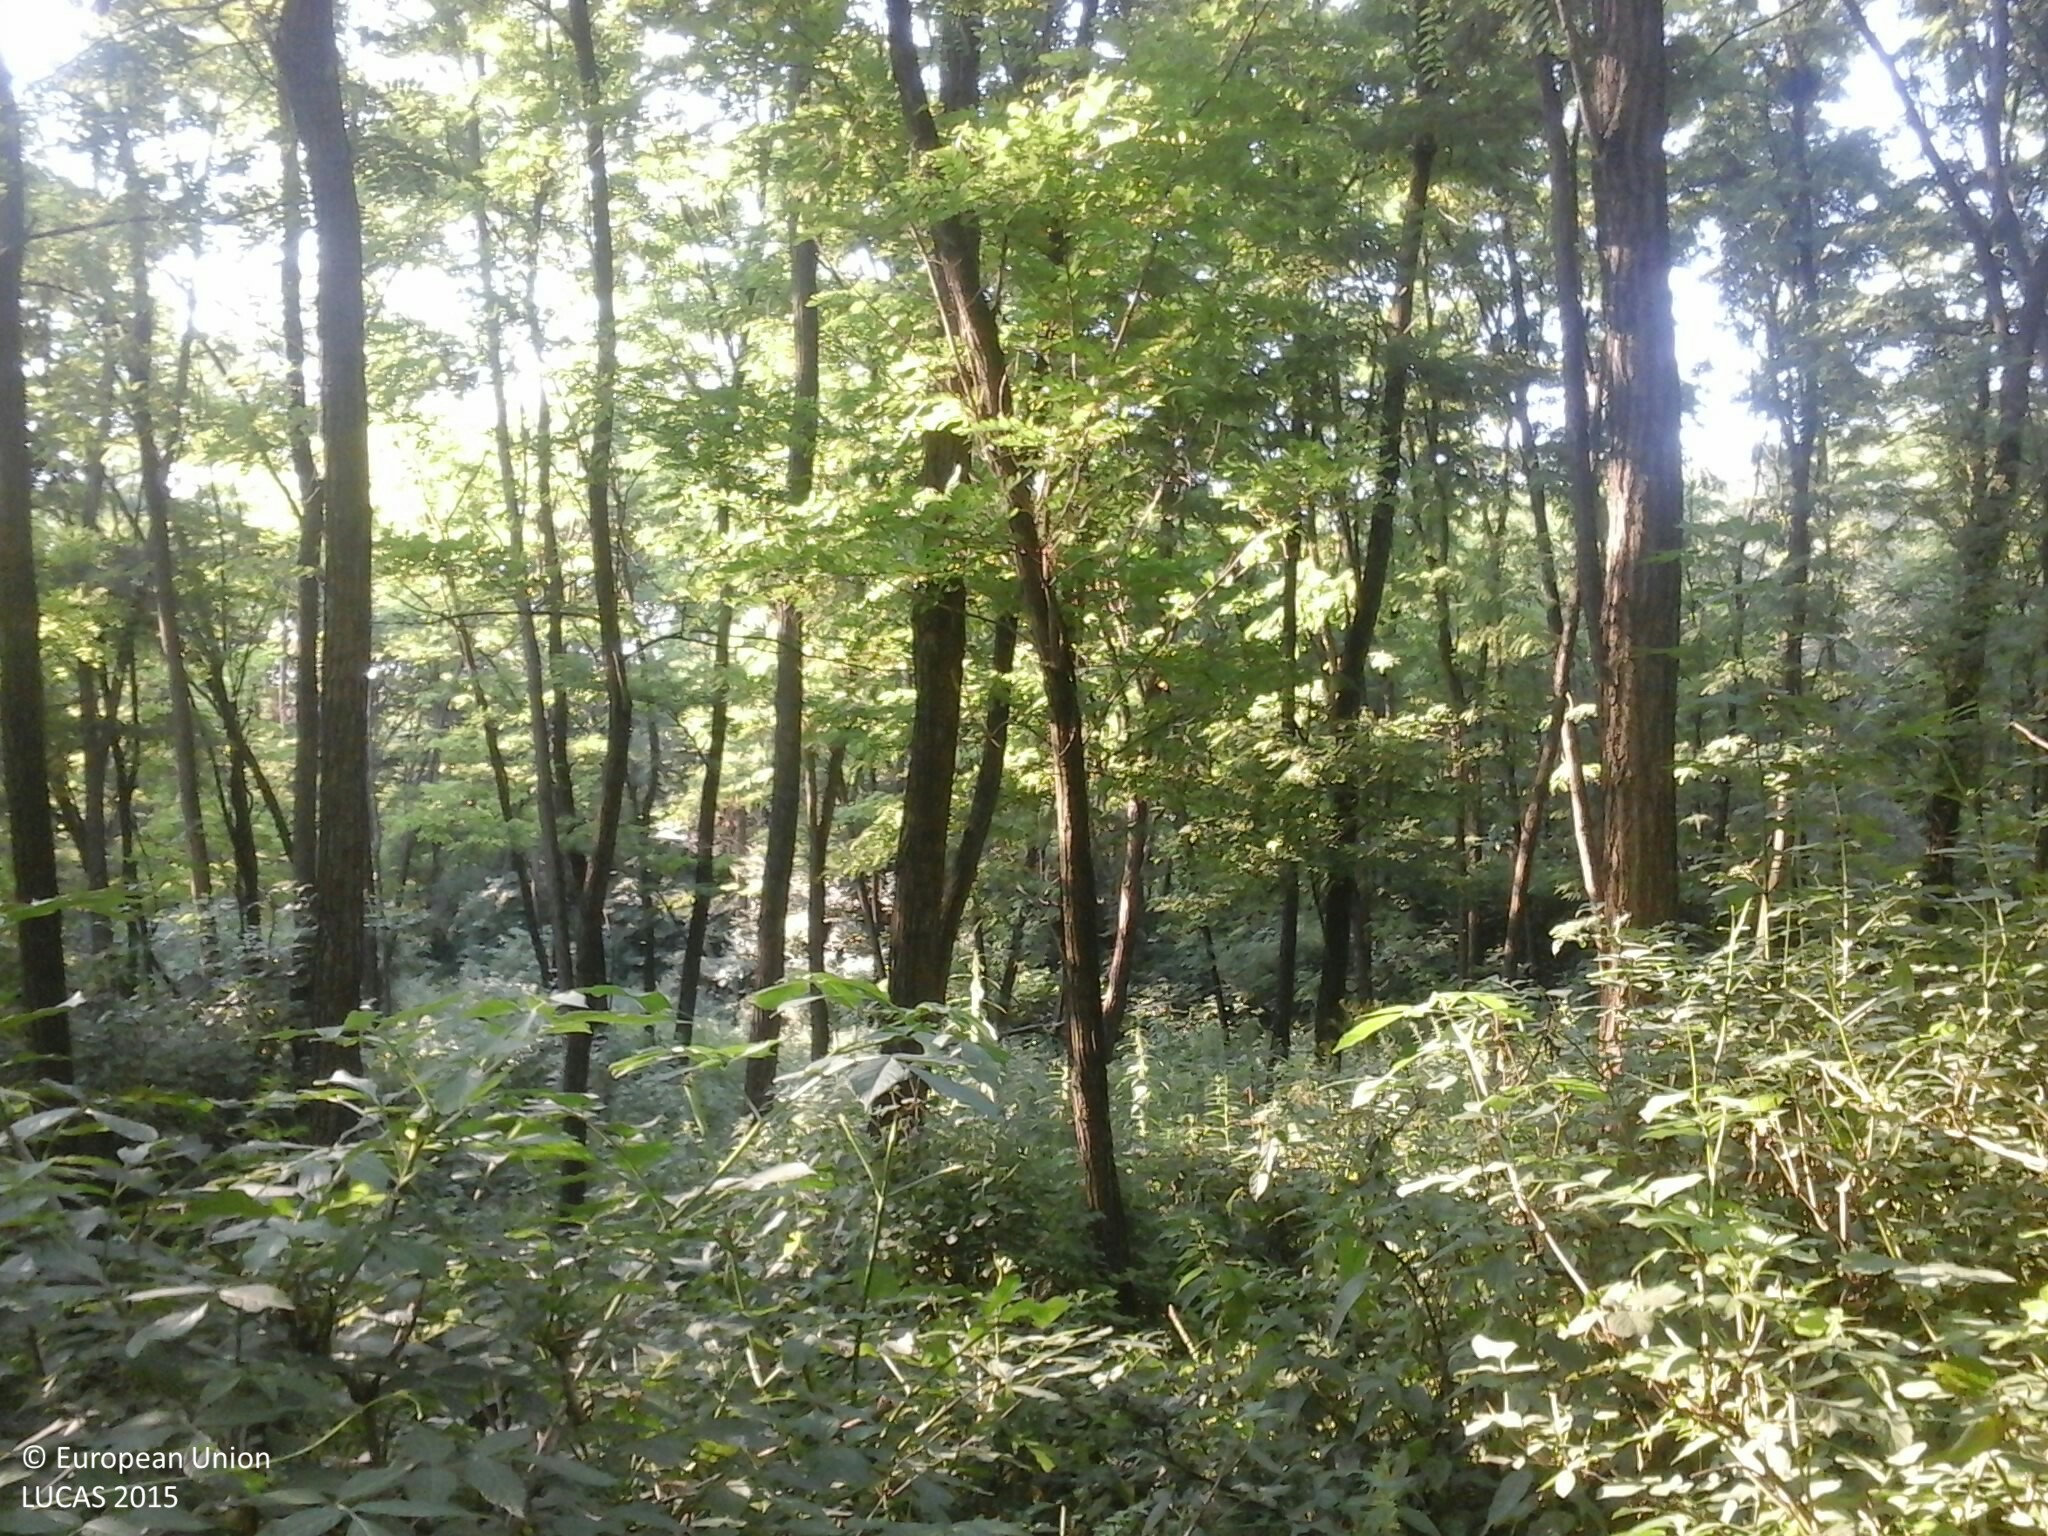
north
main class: Woodland
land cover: Broadleaved woodland
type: exotic forest
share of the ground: > 75 %
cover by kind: broadleaved forest trees 90 %, shrubs 10 %
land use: Forestry
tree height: > 5 m
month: July
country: HU
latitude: 47.3659
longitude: 17.8352
